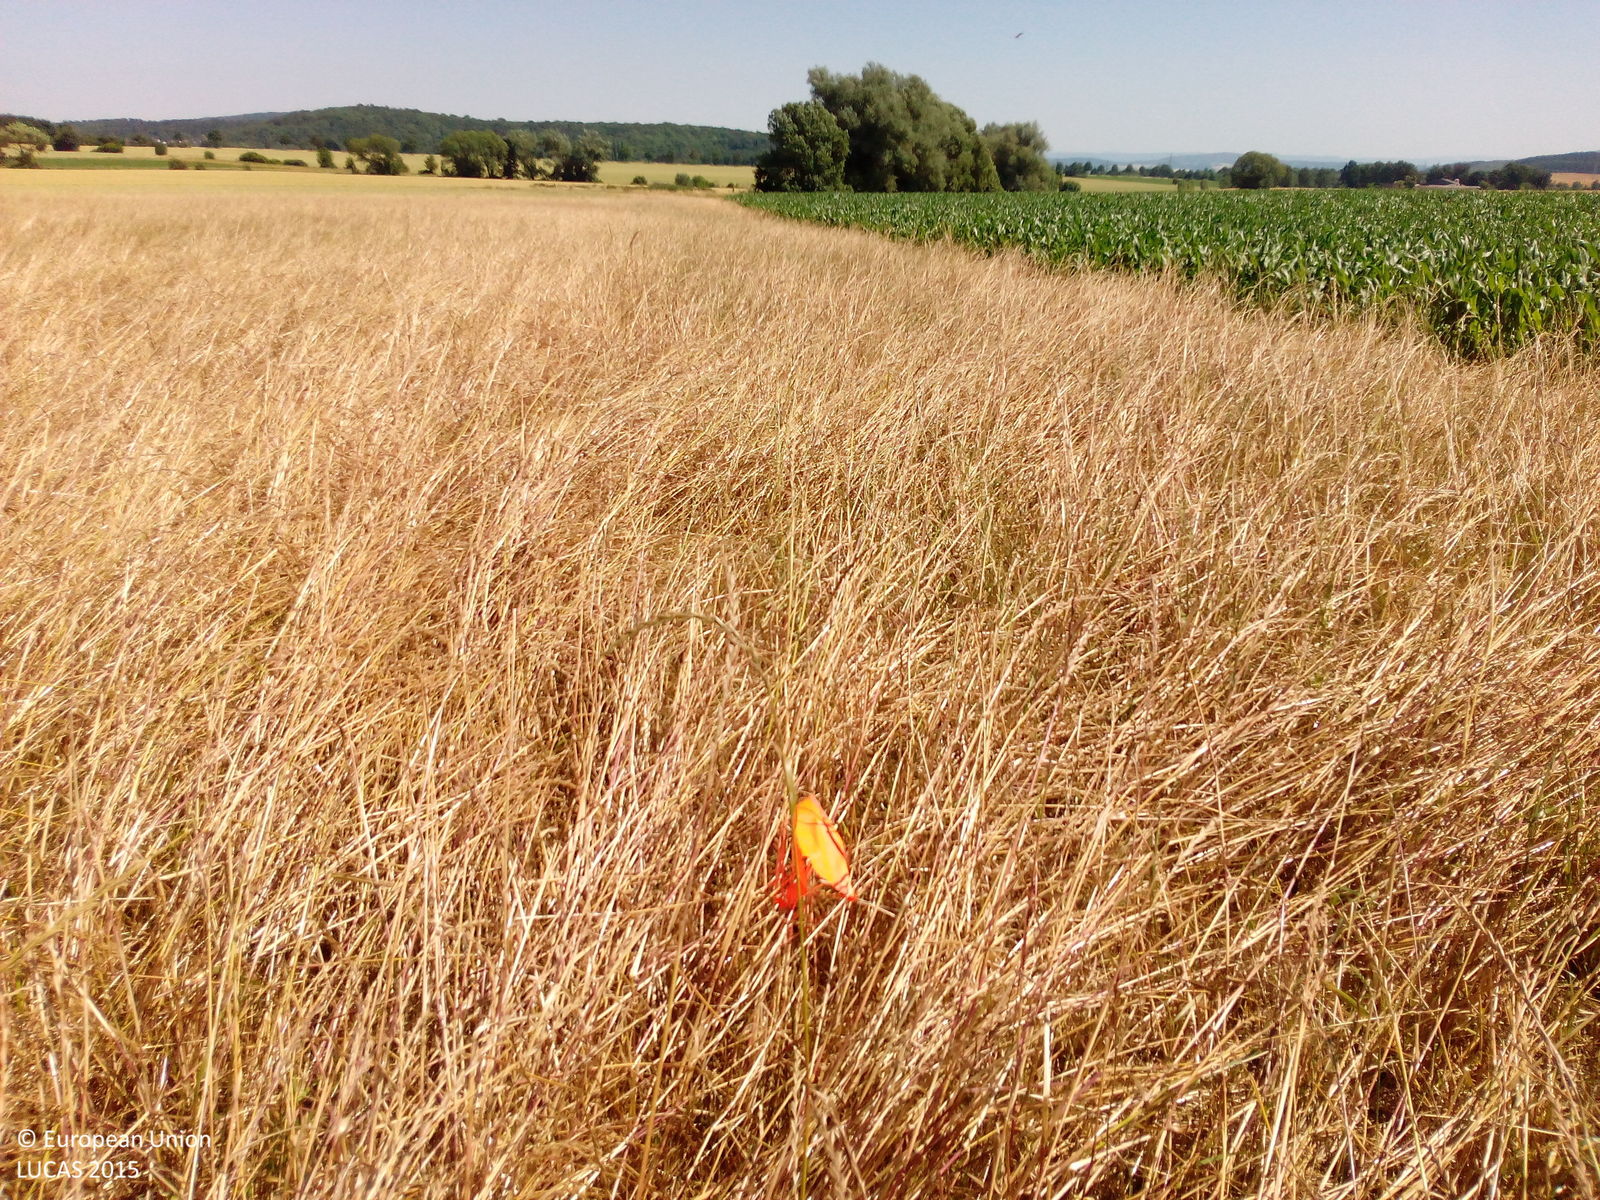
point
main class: Grassland
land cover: Grassland without tree/shrub cover
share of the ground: > 75 %
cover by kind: herbaceous plants 100 %
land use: Agriculture (excluding fallow land and kitchen gardens)
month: July
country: DE
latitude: 51.6764
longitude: 9.8699
